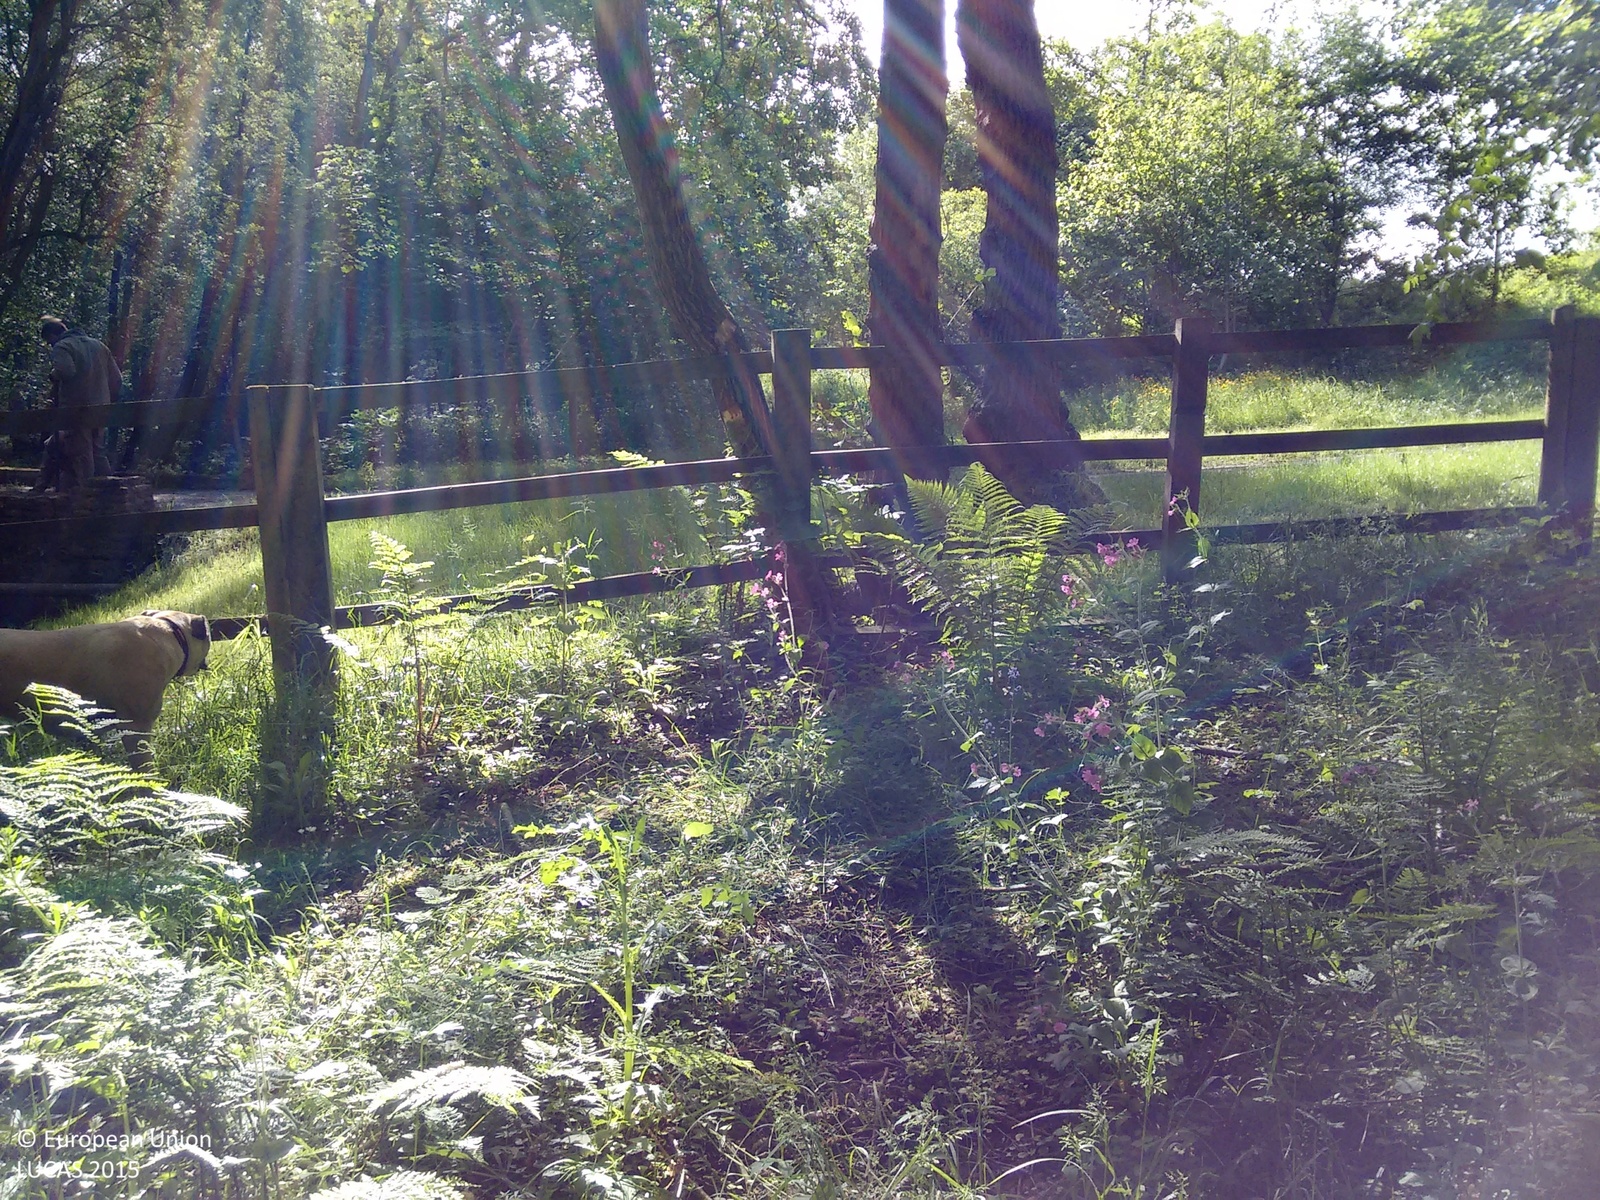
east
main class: Woodland
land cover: Broadleaved woodland
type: mesophytic deciduous forest
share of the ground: > 75 %
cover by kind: broadleaved forest trees 80 %, coniferous forest trees 20 %
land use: Sport
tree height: > 5 m
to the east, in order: Broadleaved woodland; Fences; Tracks; Broadleaved woodland; Fences; Grassland without tree/shrub cover; Inland fresh water bodies
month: June
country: GB
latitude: 54.1471
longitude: -1.0507
